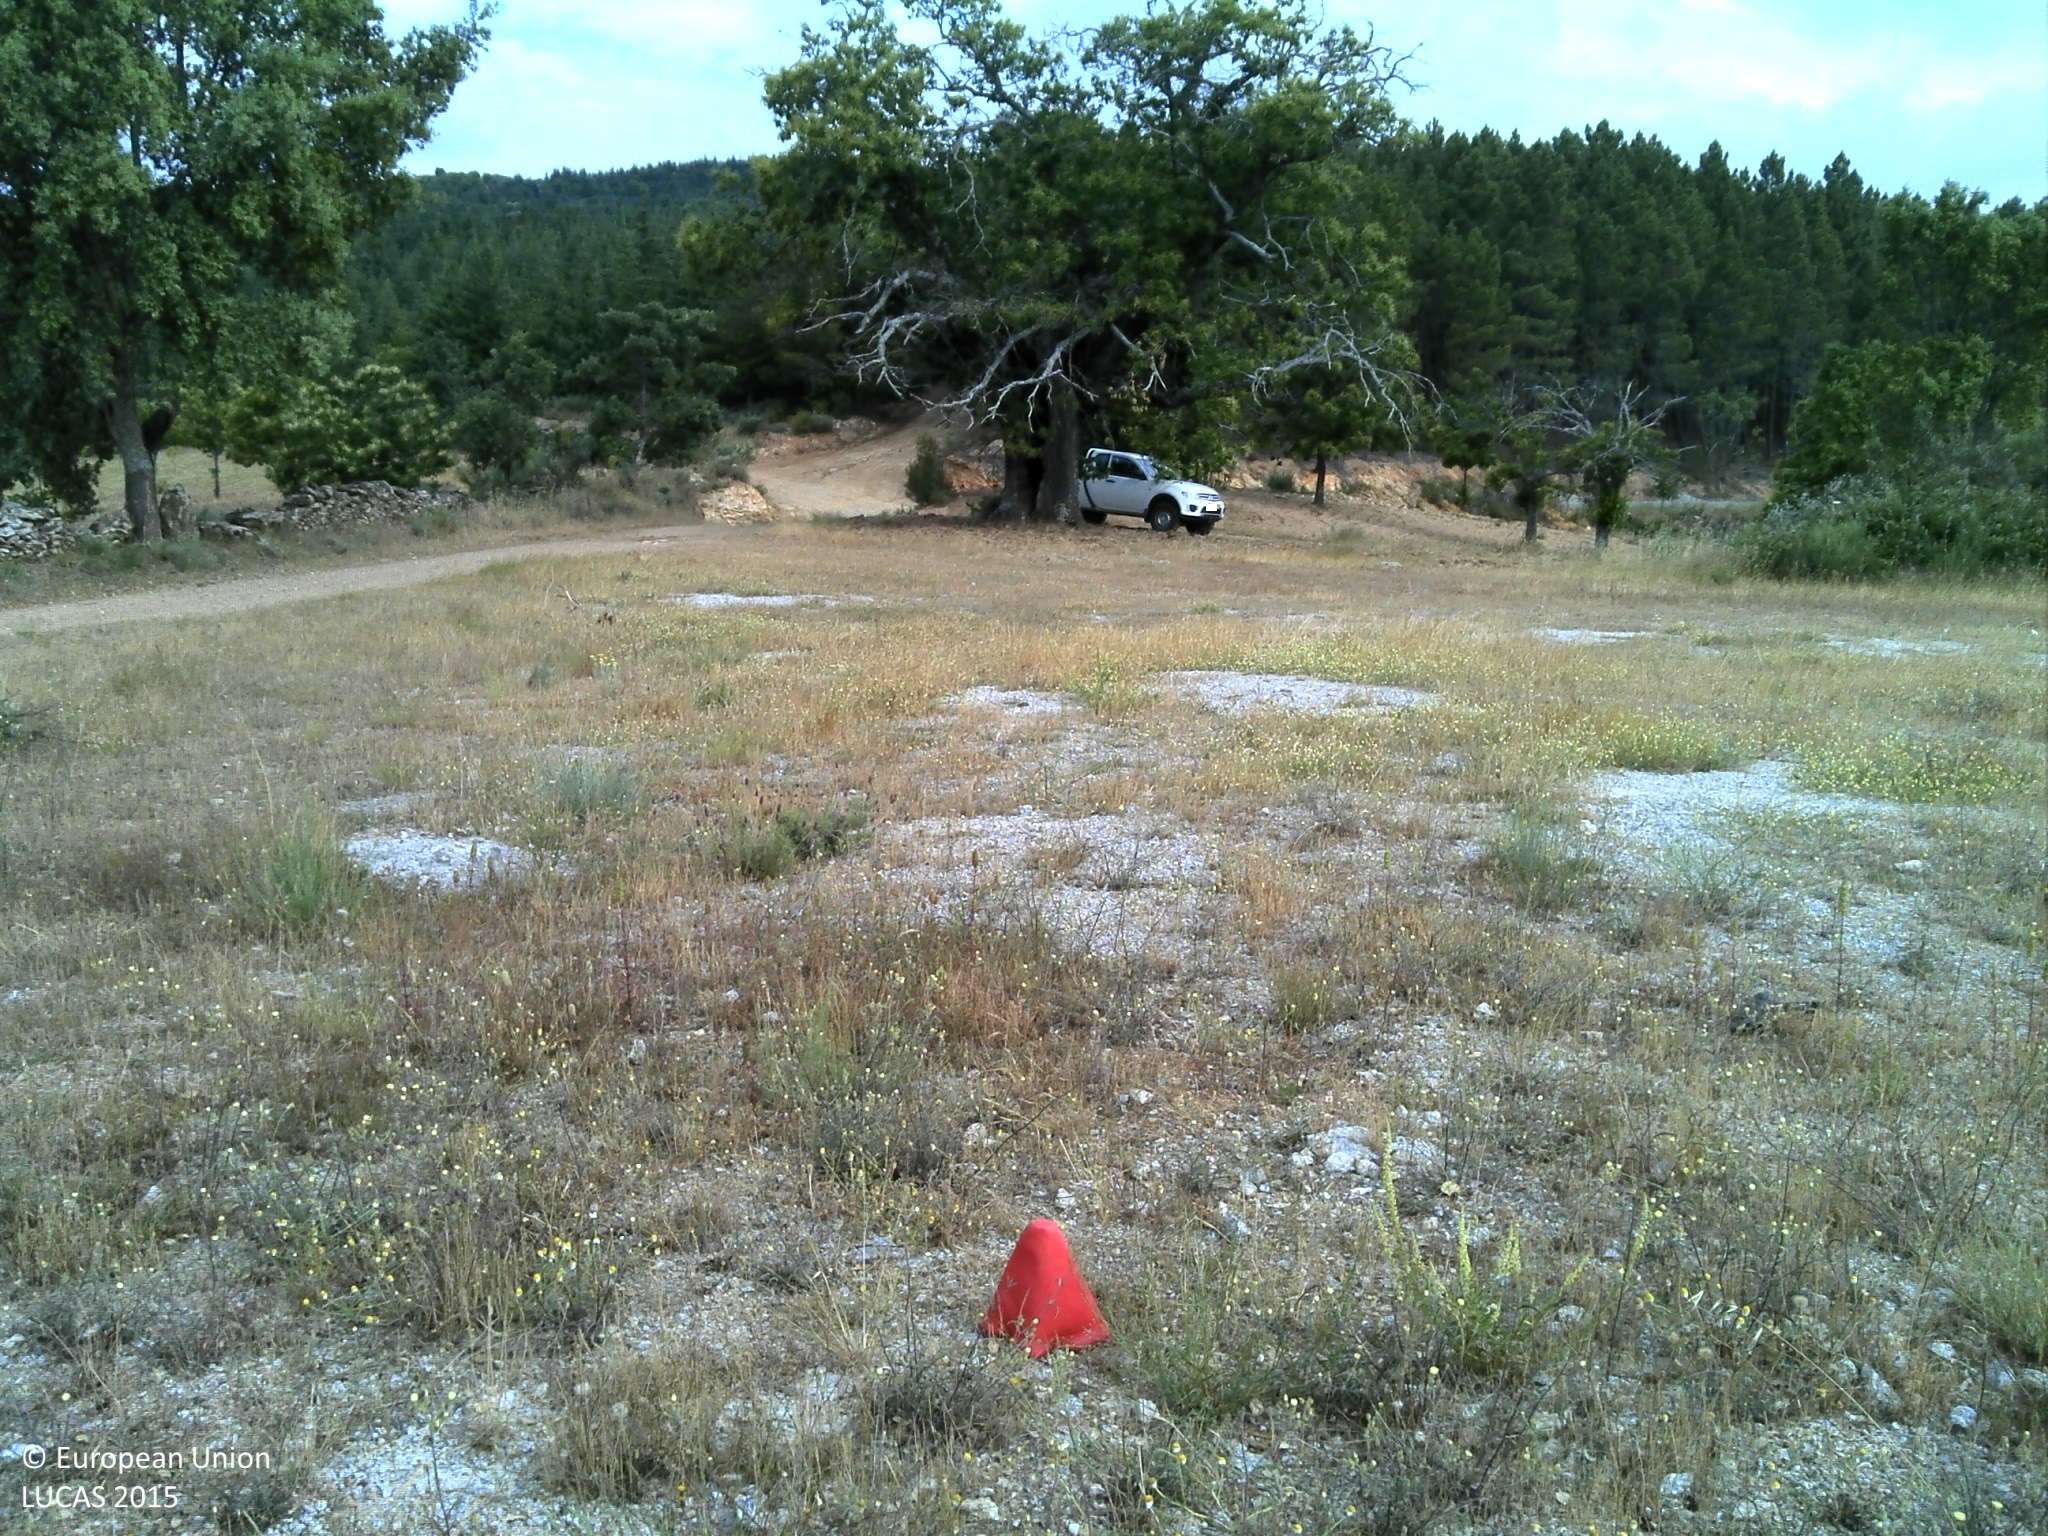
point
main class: Grassland
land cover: Grassland without tree/shrub cover
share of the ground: 10 - 25 %
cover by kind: consolidated bare surface 60 %, unconsolidated bare surface 20 %, herbaceous plants 15 %, shrubs 5 %
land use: Semi-natural and natural areas not in use
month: June
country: PT
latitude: 41.3909
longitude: -6.9873
